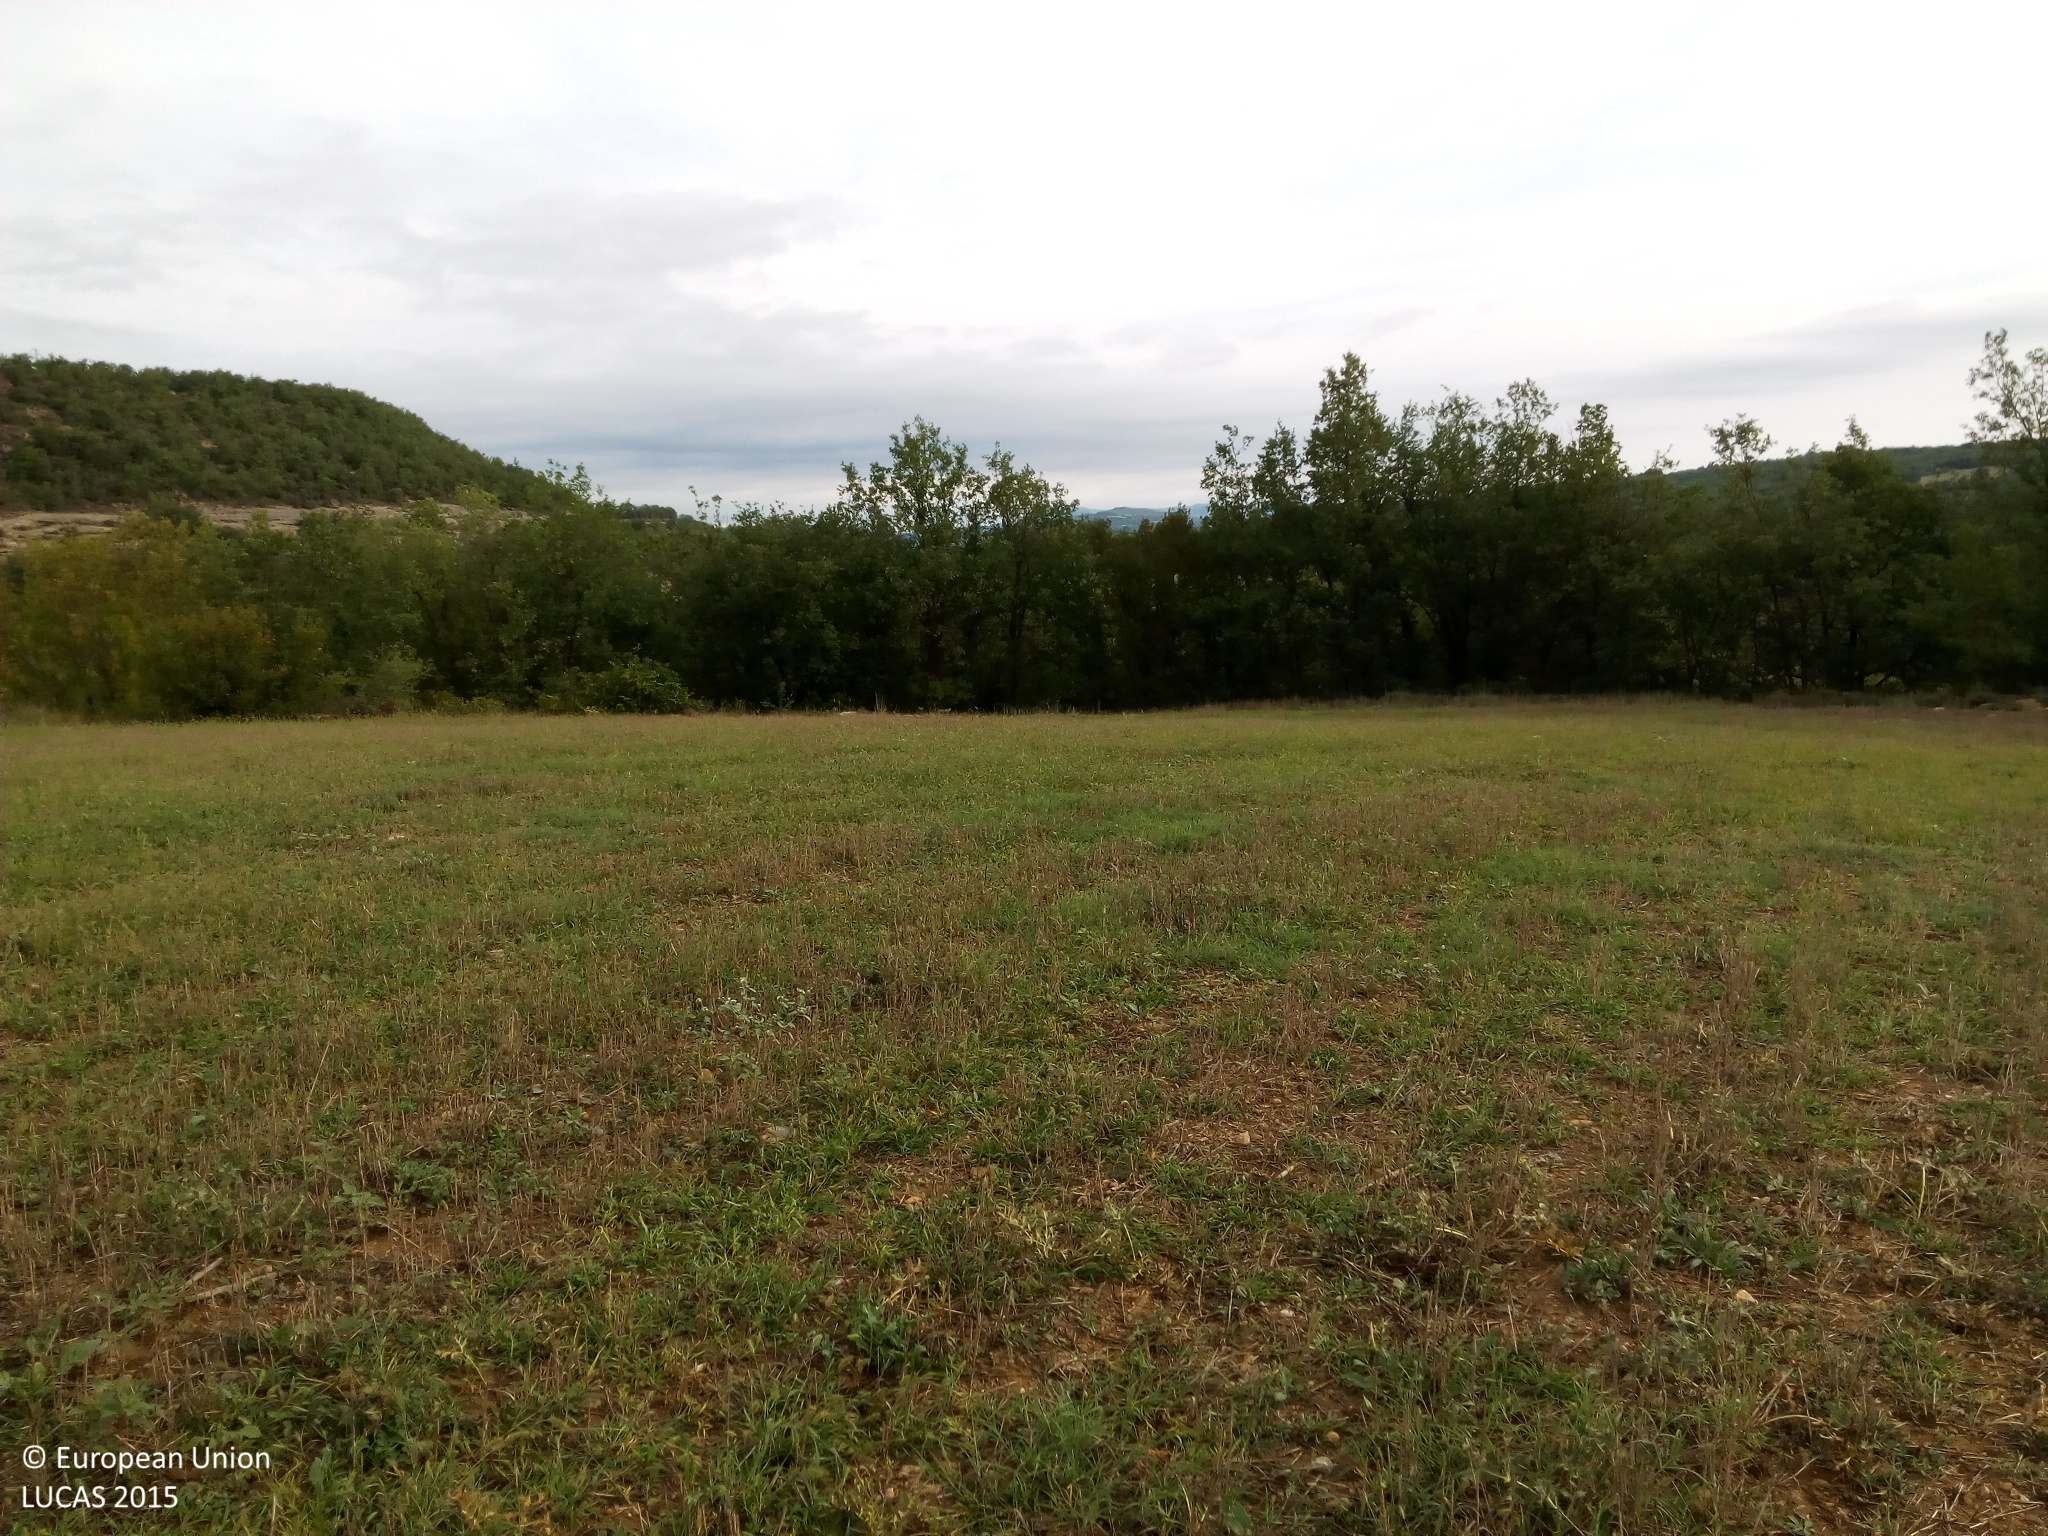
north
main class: Cropland
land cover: Common wheat
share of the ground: < 10 %
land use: Agriculture (excluding fallow land and kitchen gardens)
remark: Harvested field
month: August
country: ES
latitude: 42.1595
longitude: 0.5792
